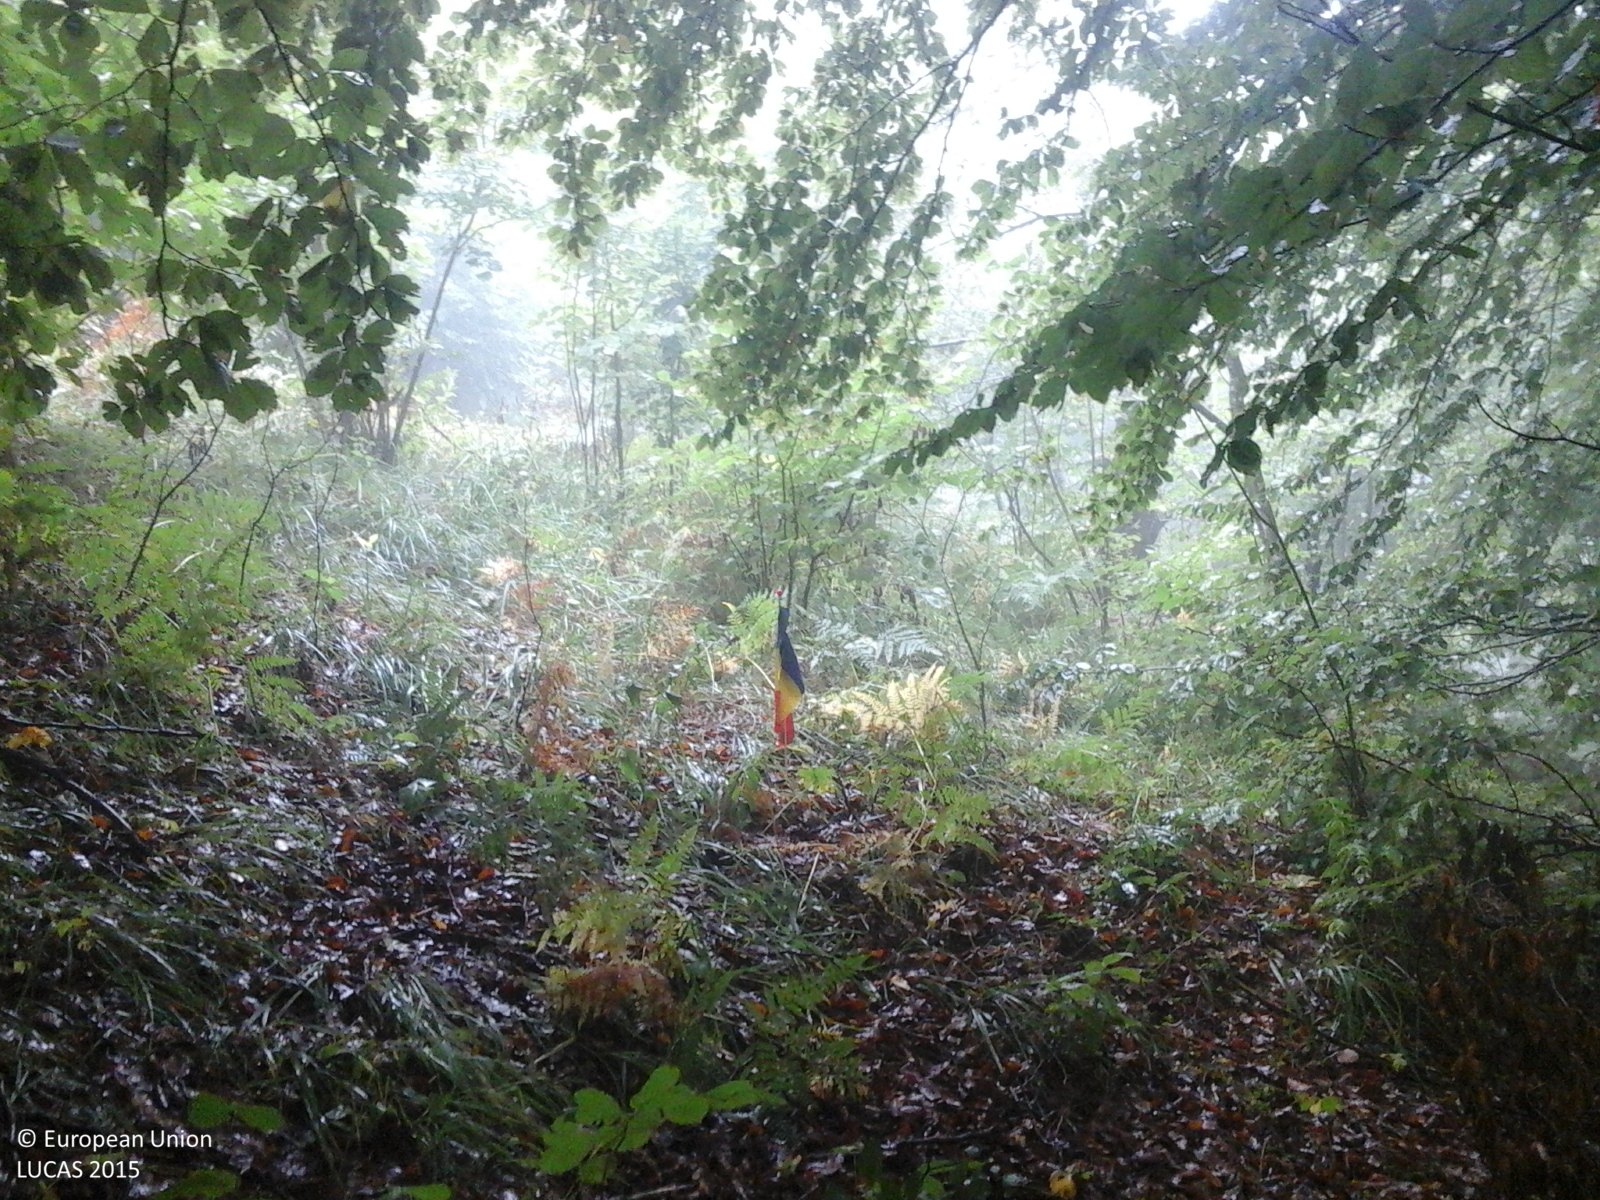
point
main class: Woodland
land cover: Broadleaved woodland
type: mesophytic deciduous forest
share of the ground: > 75 %
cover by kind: broadleaved forest trees 100 %
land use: Forestry
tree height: > 5 m
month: September
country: RO
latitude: 45.3879
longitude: 24.0037
